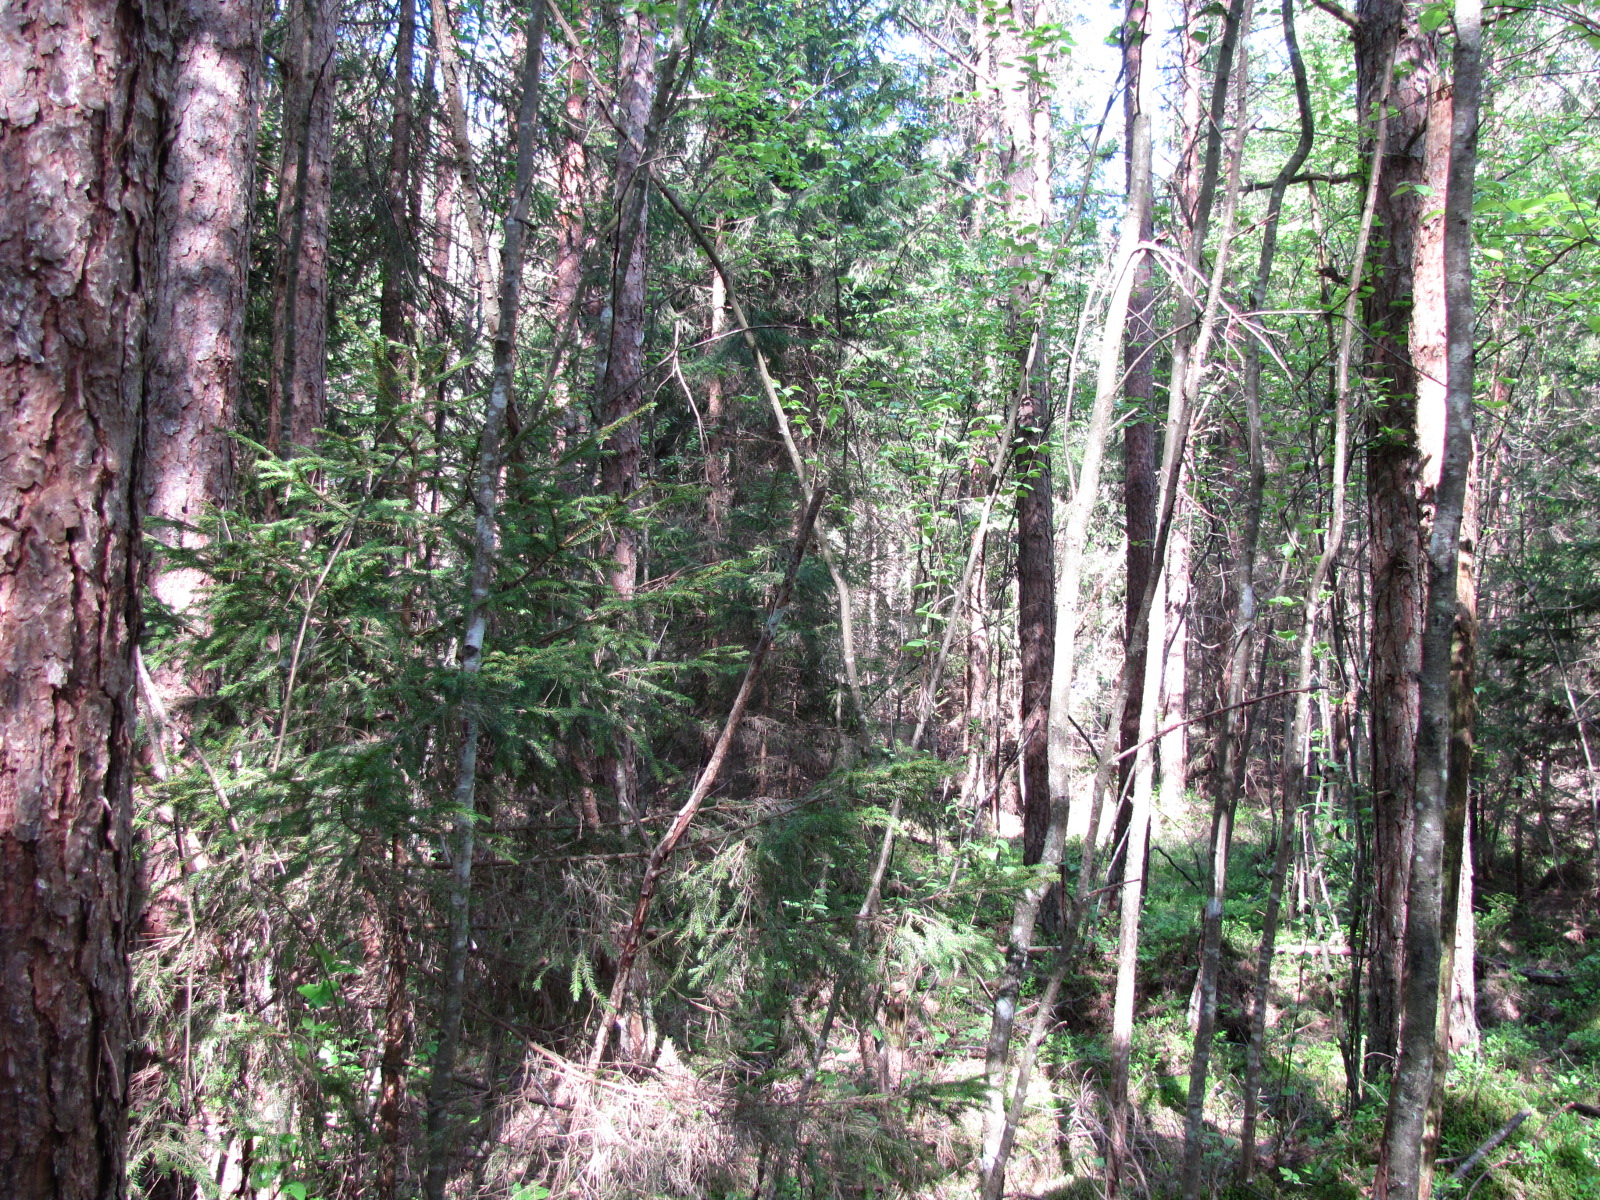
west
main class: Woodland
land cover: Other mixed woodland
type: hemiboreal forest and nemoral coniferous forest and mixed broadleaved-coniferous forest
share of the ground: > 75 %
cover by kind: coniferous forest trees 70 %, broadleaved forest trees 30 %
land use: Forestry
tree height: > 5 m
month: May
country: LV
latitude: 56.6444
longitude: 24.1278
